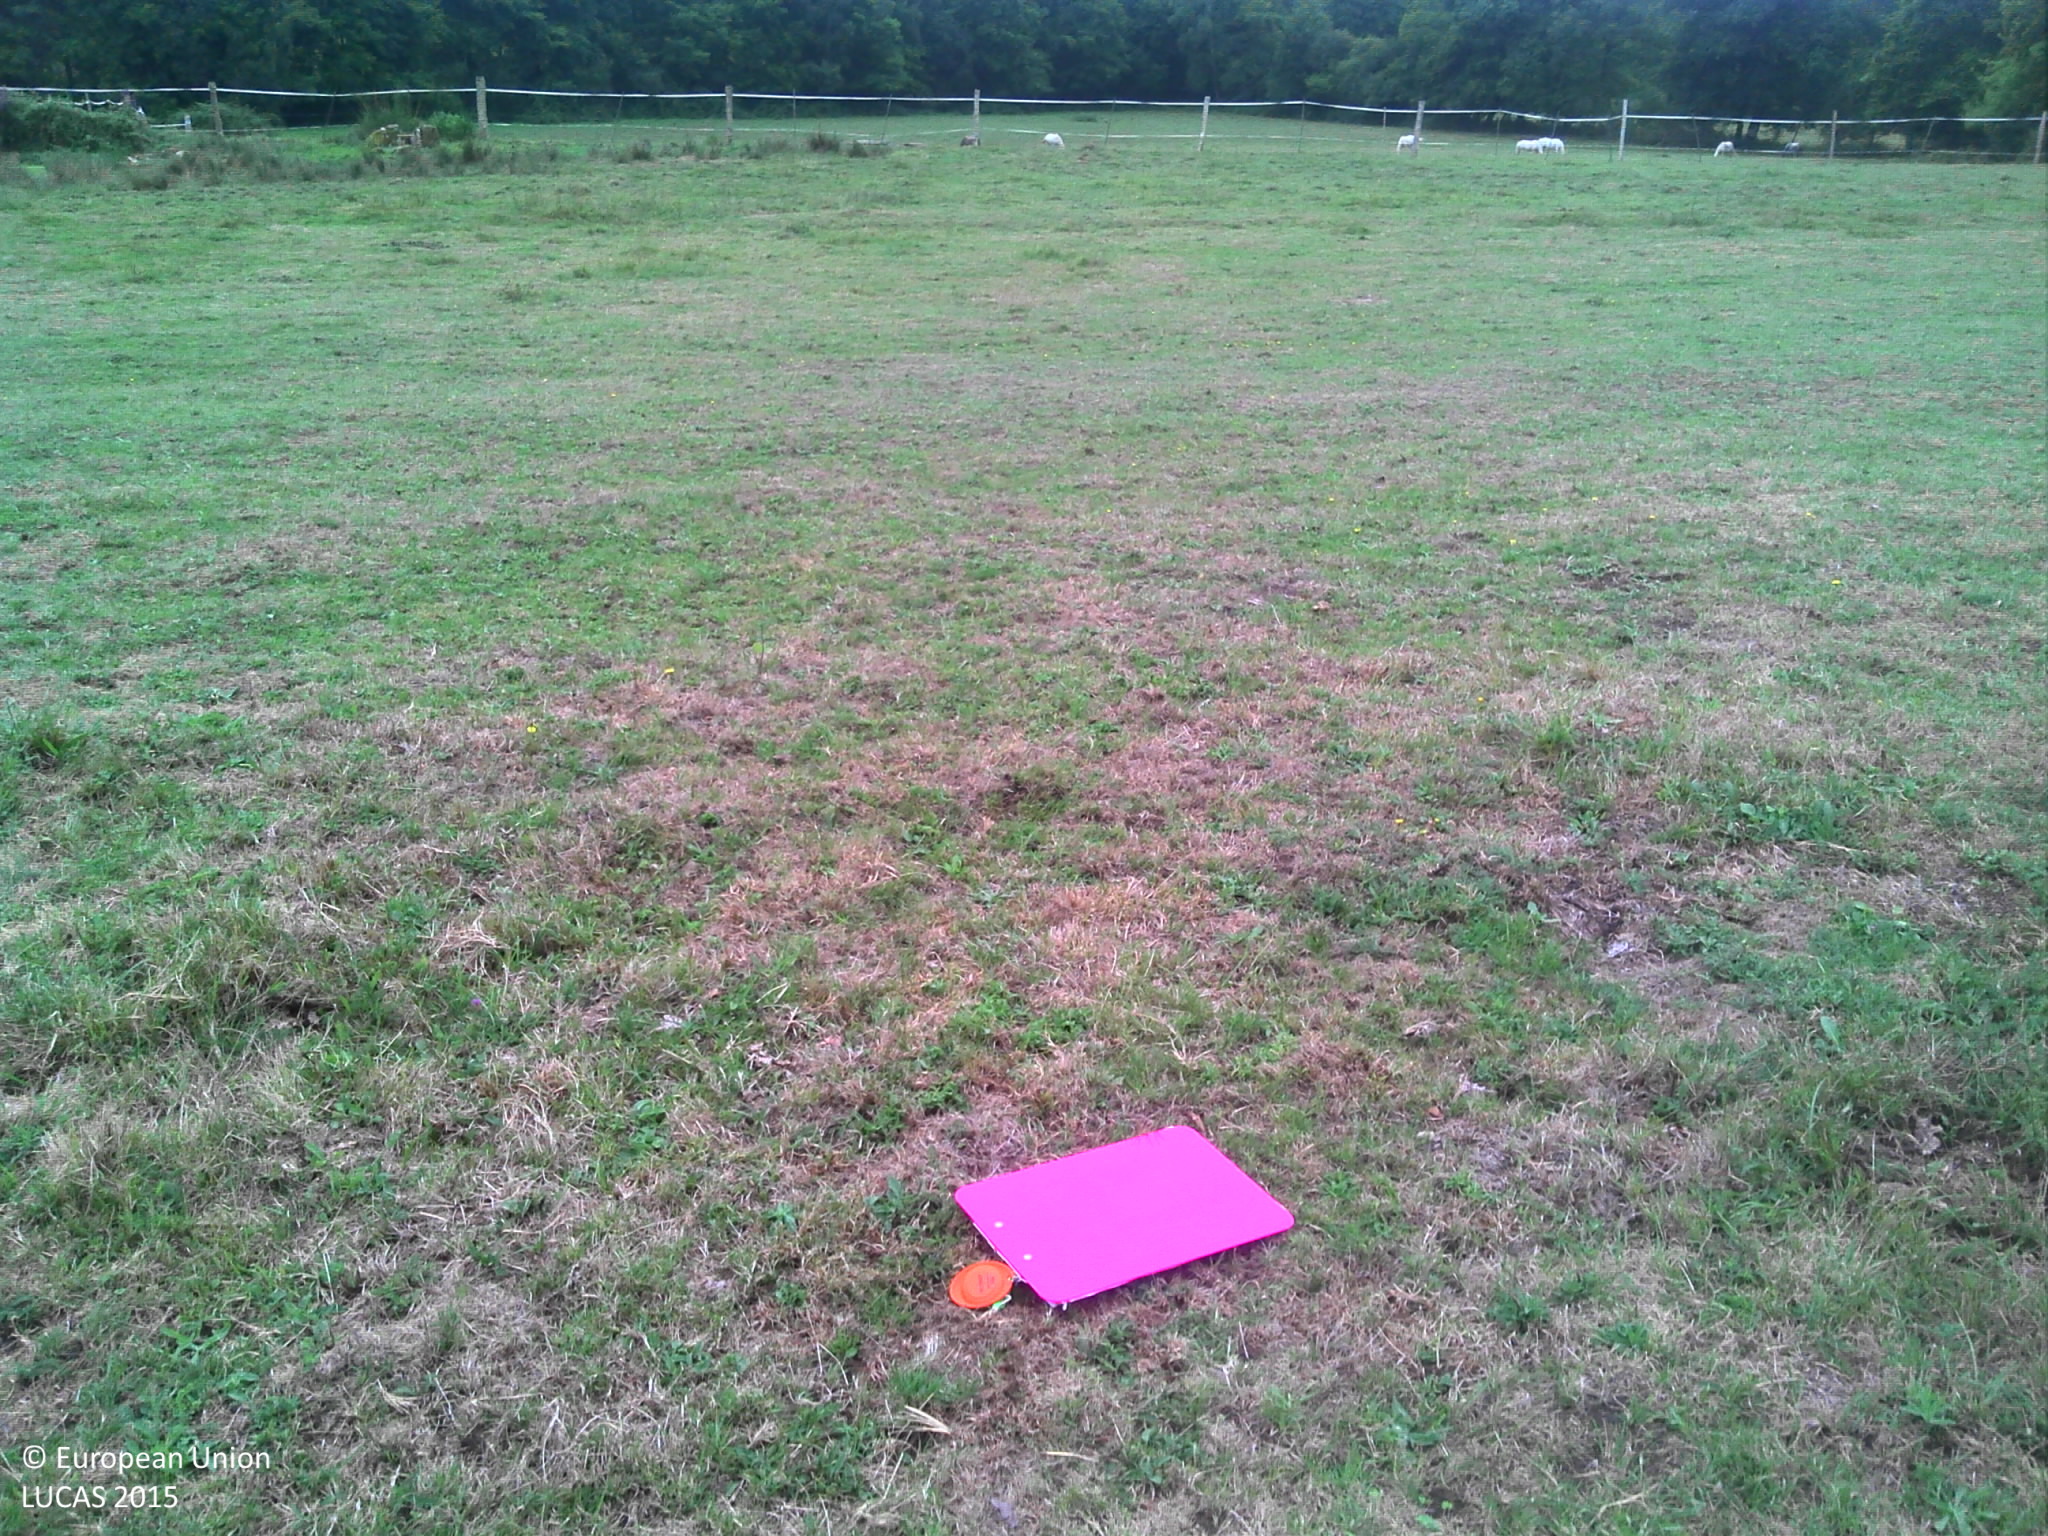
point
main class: Grassland
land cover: Grassland without tree/shrub cover
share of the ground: > 75 %
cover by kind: herbaceous plants 100 %
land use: Agriculture (excluding fallow land and kitchen gardens)
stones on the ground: 10 - 25 %
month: August
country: FR
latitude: 46.0421
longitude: 0.9813
